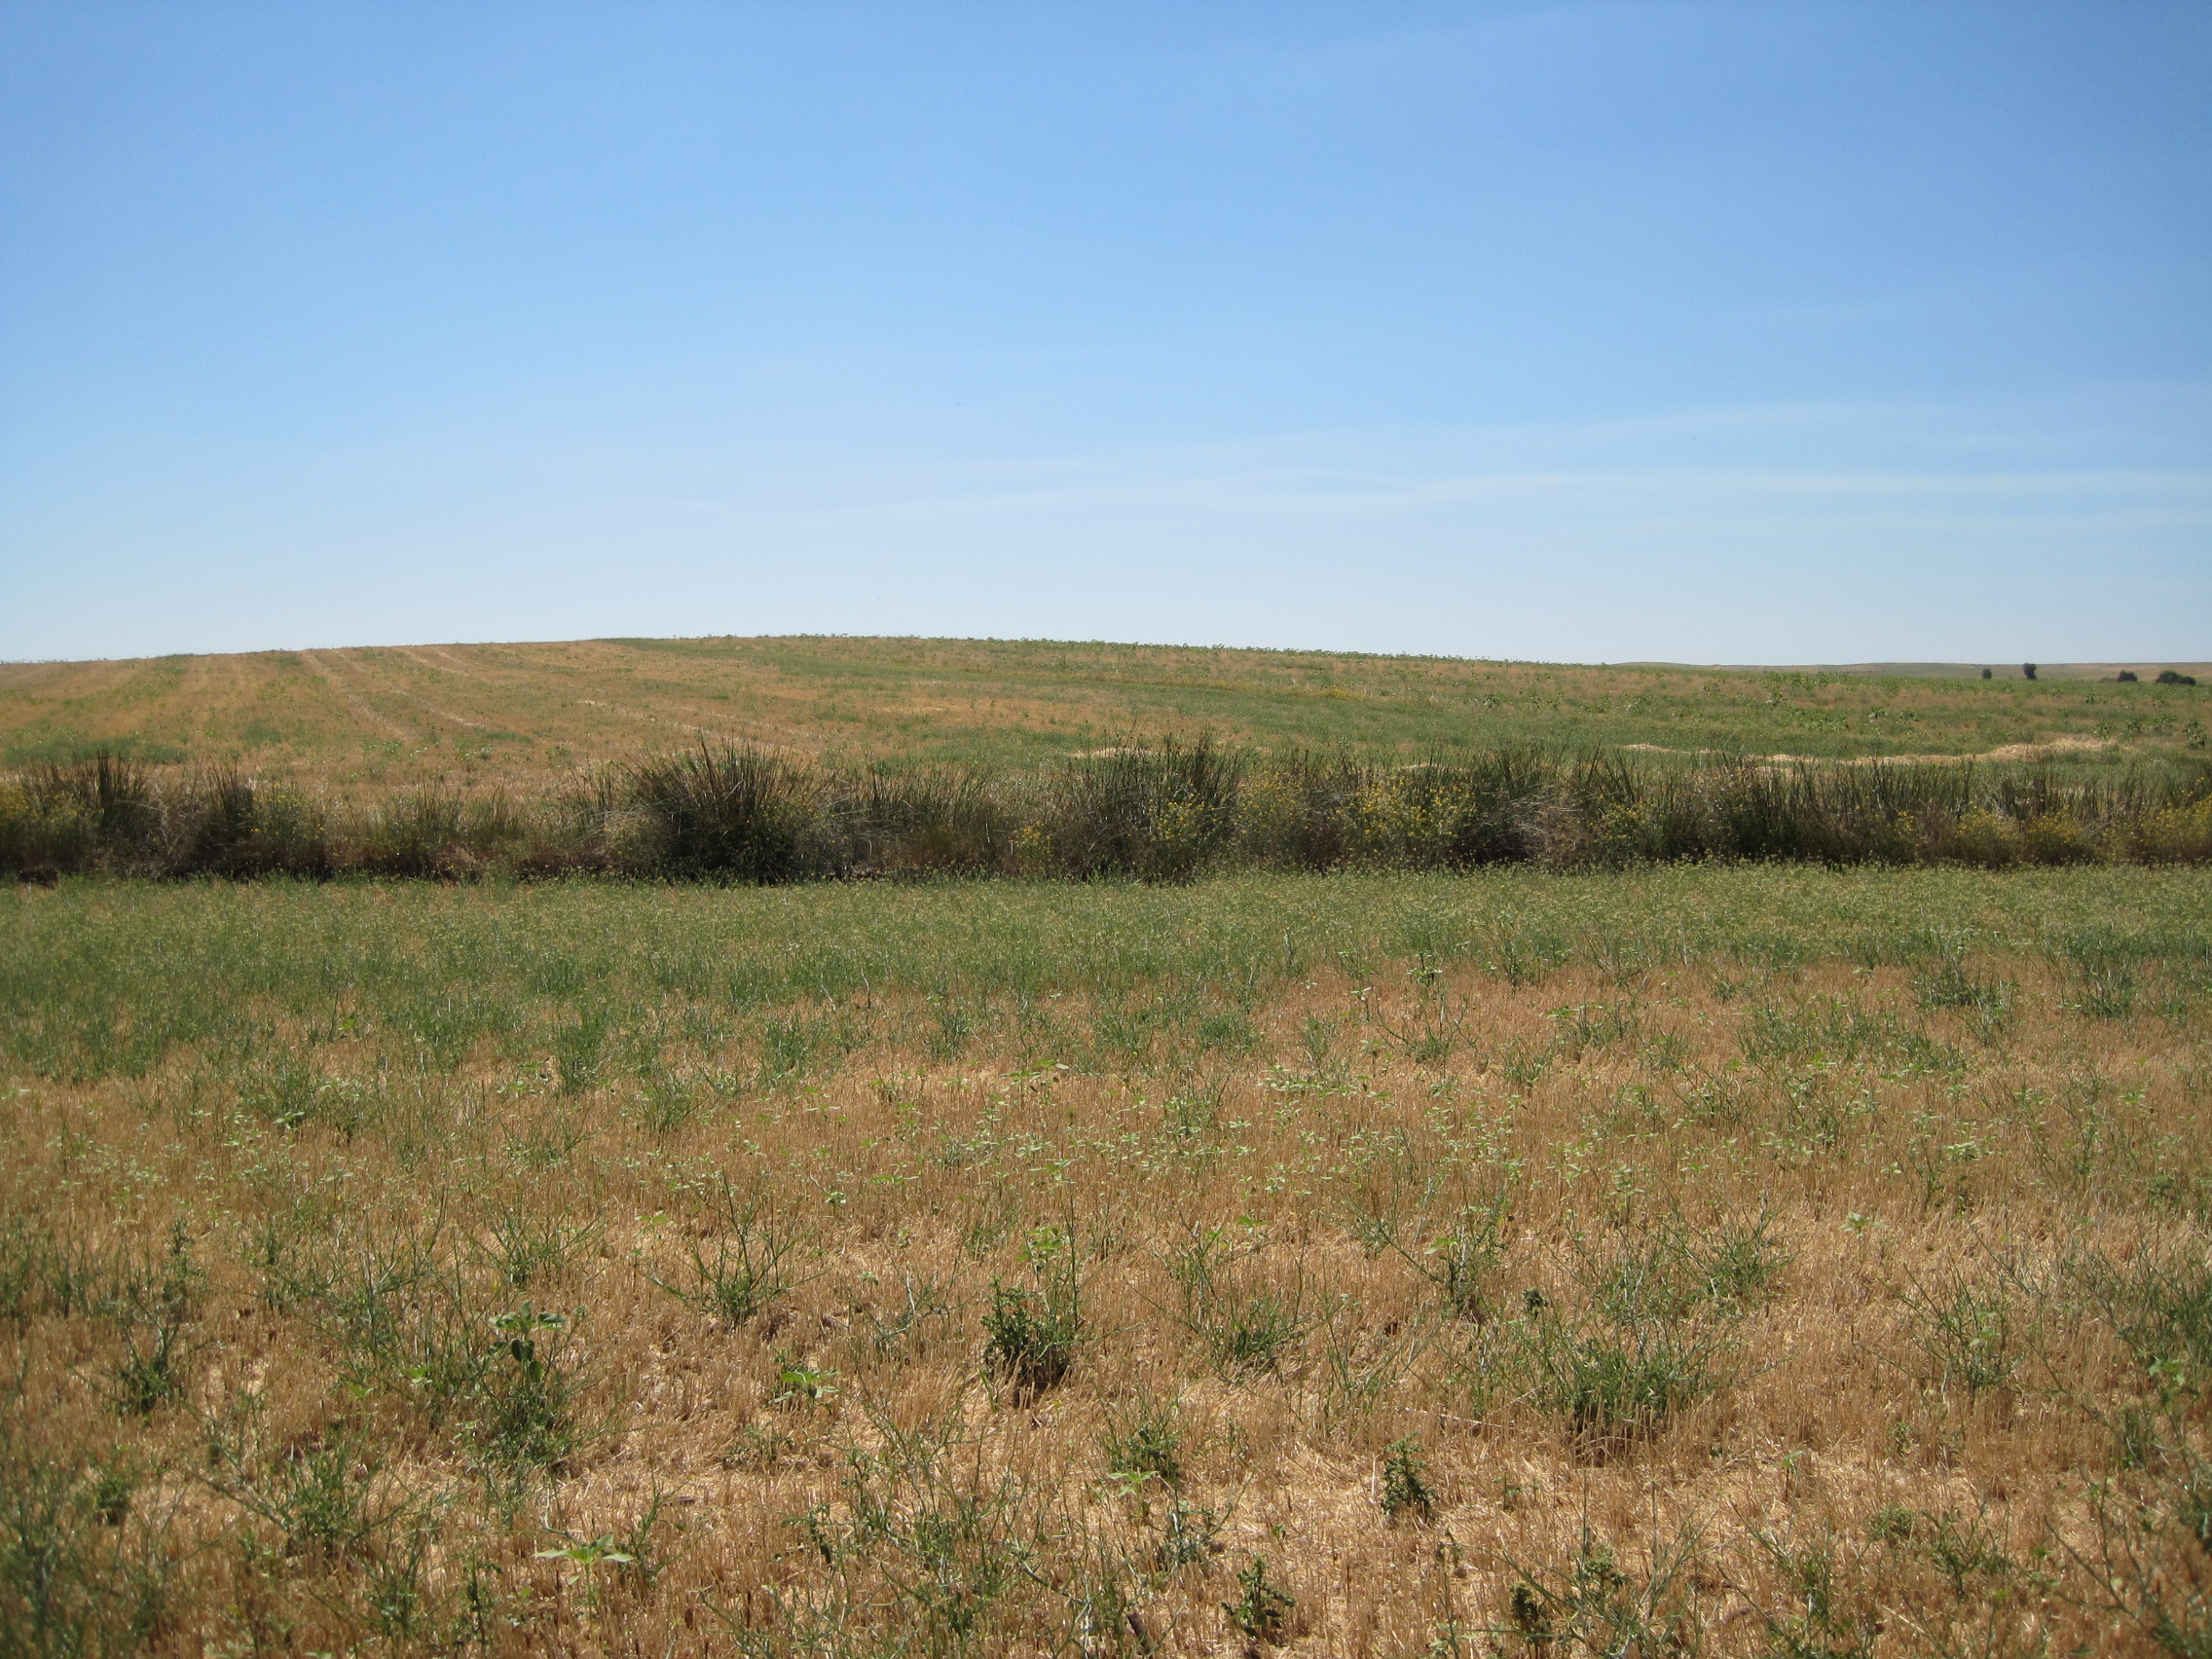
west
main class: Cropland
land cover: Barley
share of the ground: < 10 %
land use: Agriculture (excluding fallow land and kitchen gardens)
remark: Harvested field
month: July
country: ES
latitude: 42.1095
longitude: -5.2869
